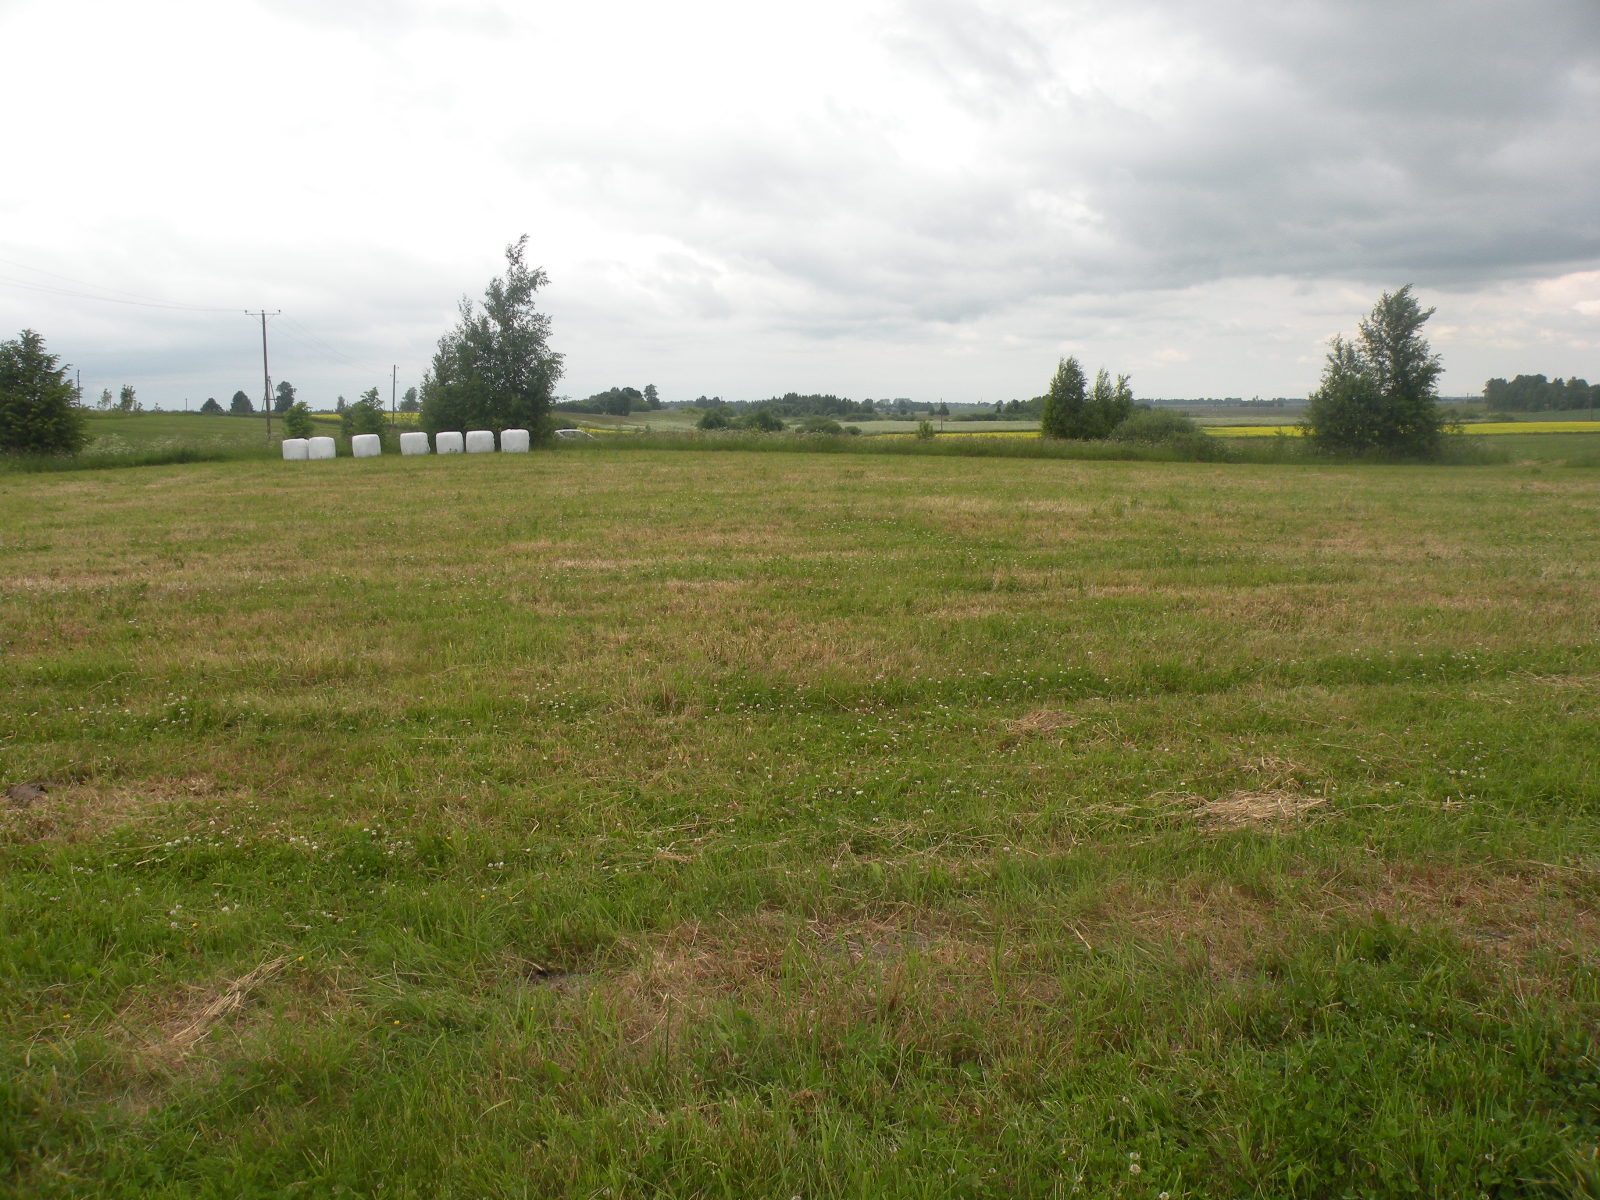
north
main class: Grassland
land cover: Grassland without tree/shrub cover
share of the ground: > 75 %
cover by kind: herbaceous plants 100 %
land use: Agriculture (excluding fallow land and kitchen gardens)
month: June
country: LV
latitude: 56.0425
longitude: 26.6730
